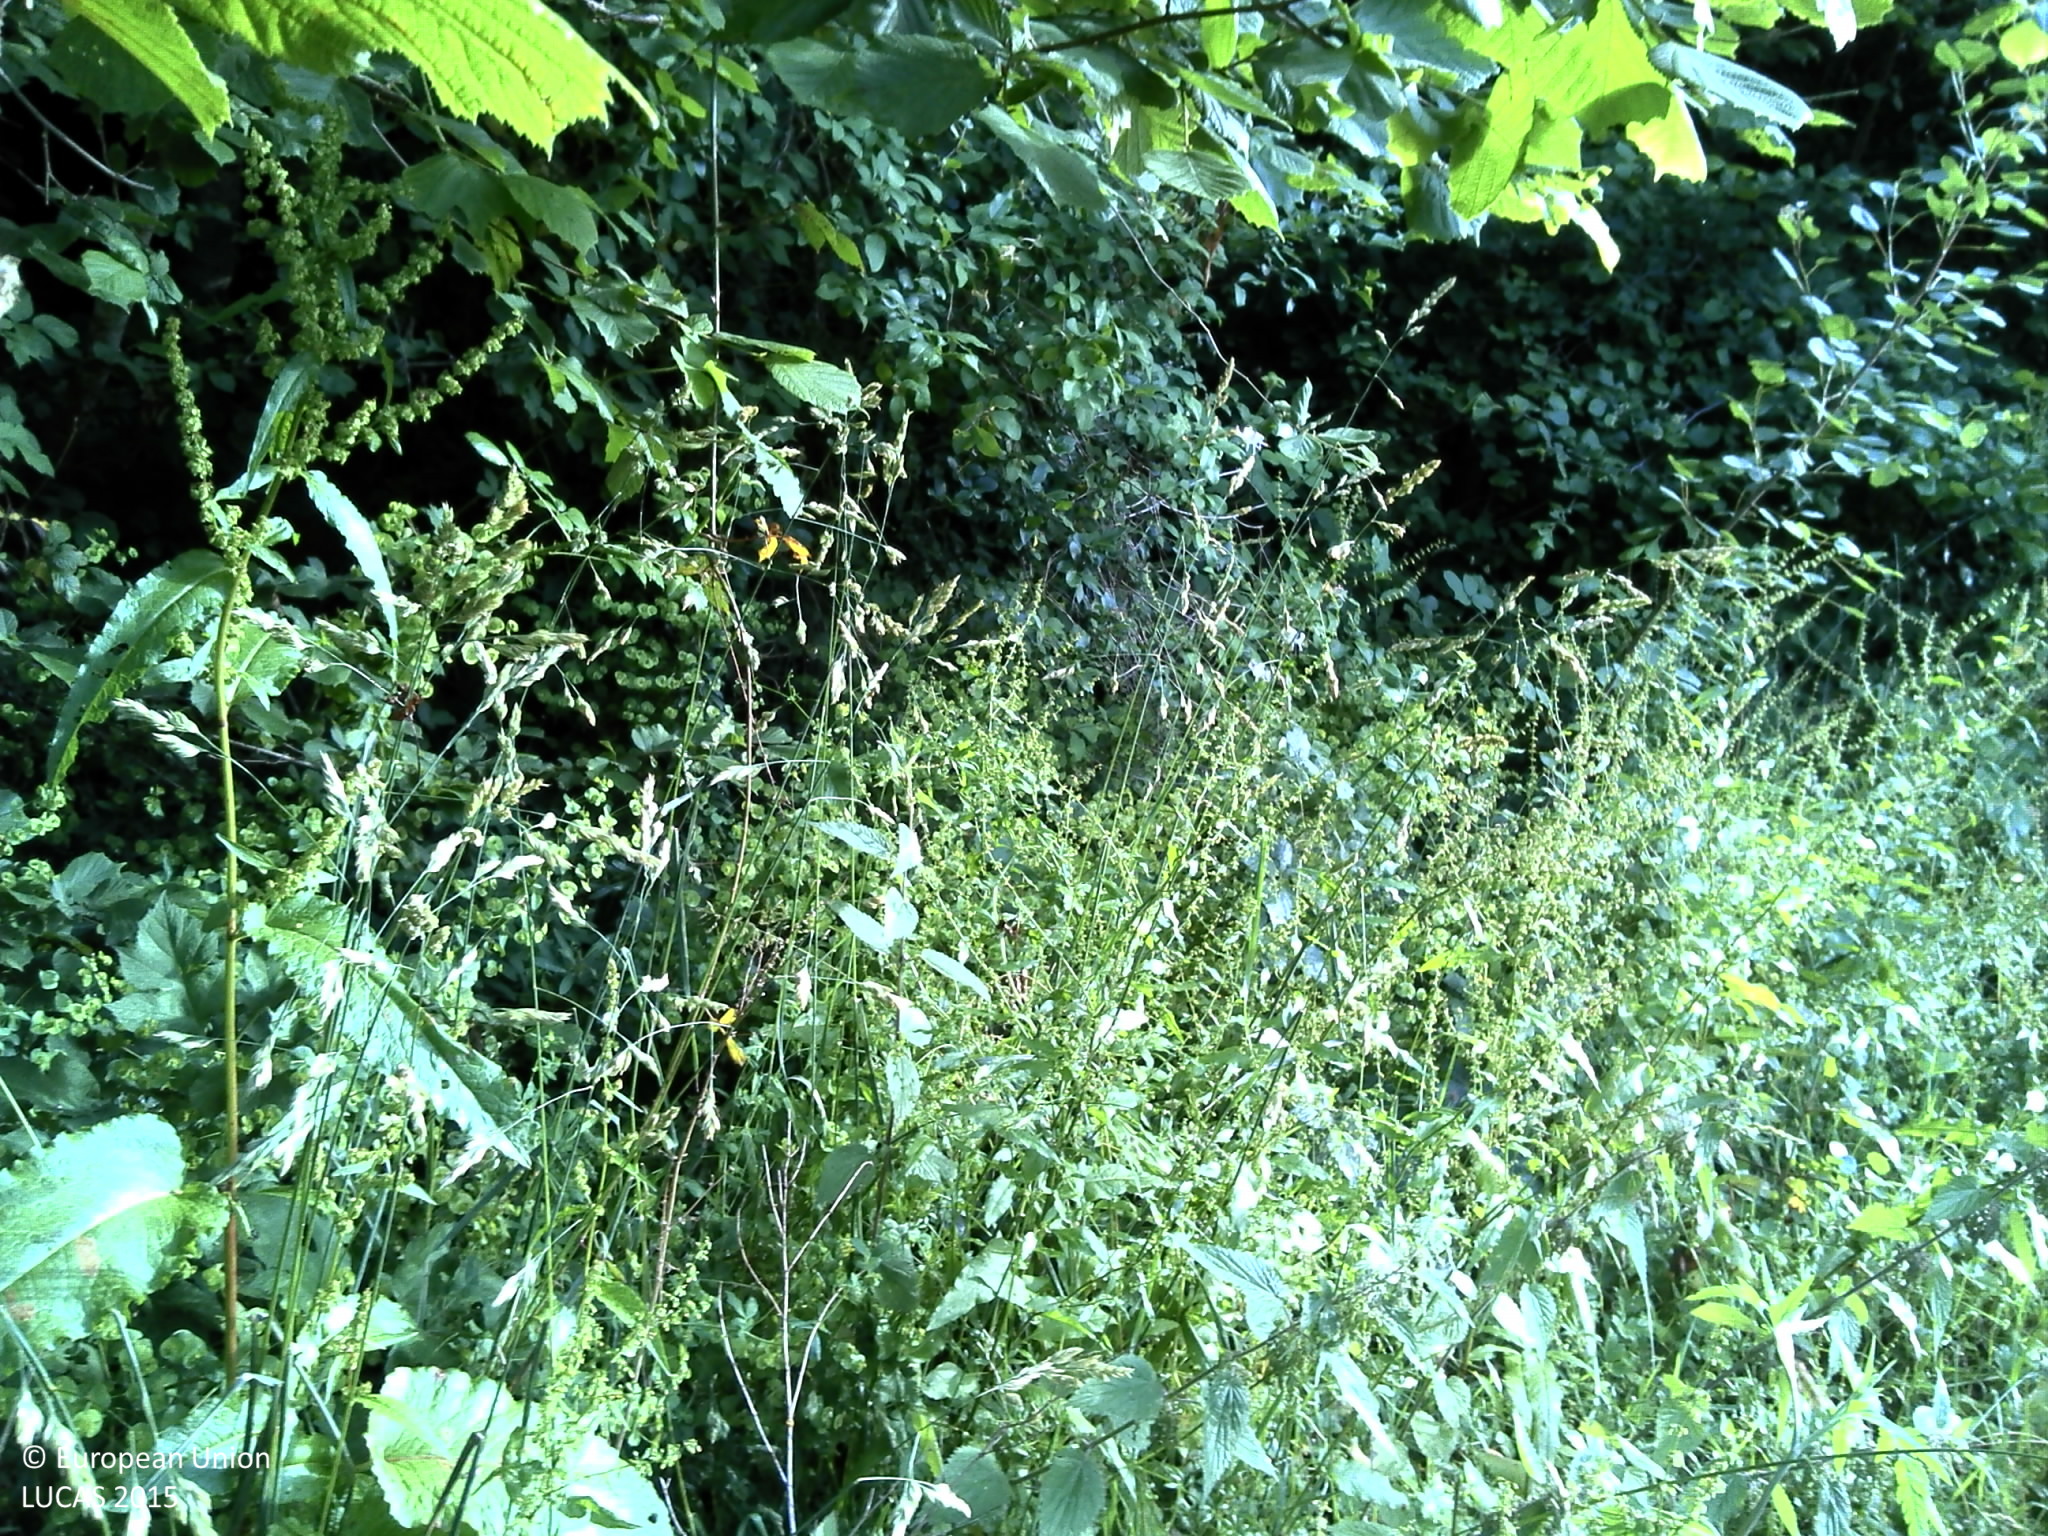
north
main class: Woodland
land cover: Broadleaved woodland
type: acidophilous oak and oak-birch forest
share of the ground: 50 - 75 %
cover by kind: broadleaved forest trees 70 %, herbaceous plants 30 %
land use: Forestry
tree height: > 5 m
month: June
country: FR
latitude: 49.7150
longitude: 0.9483
